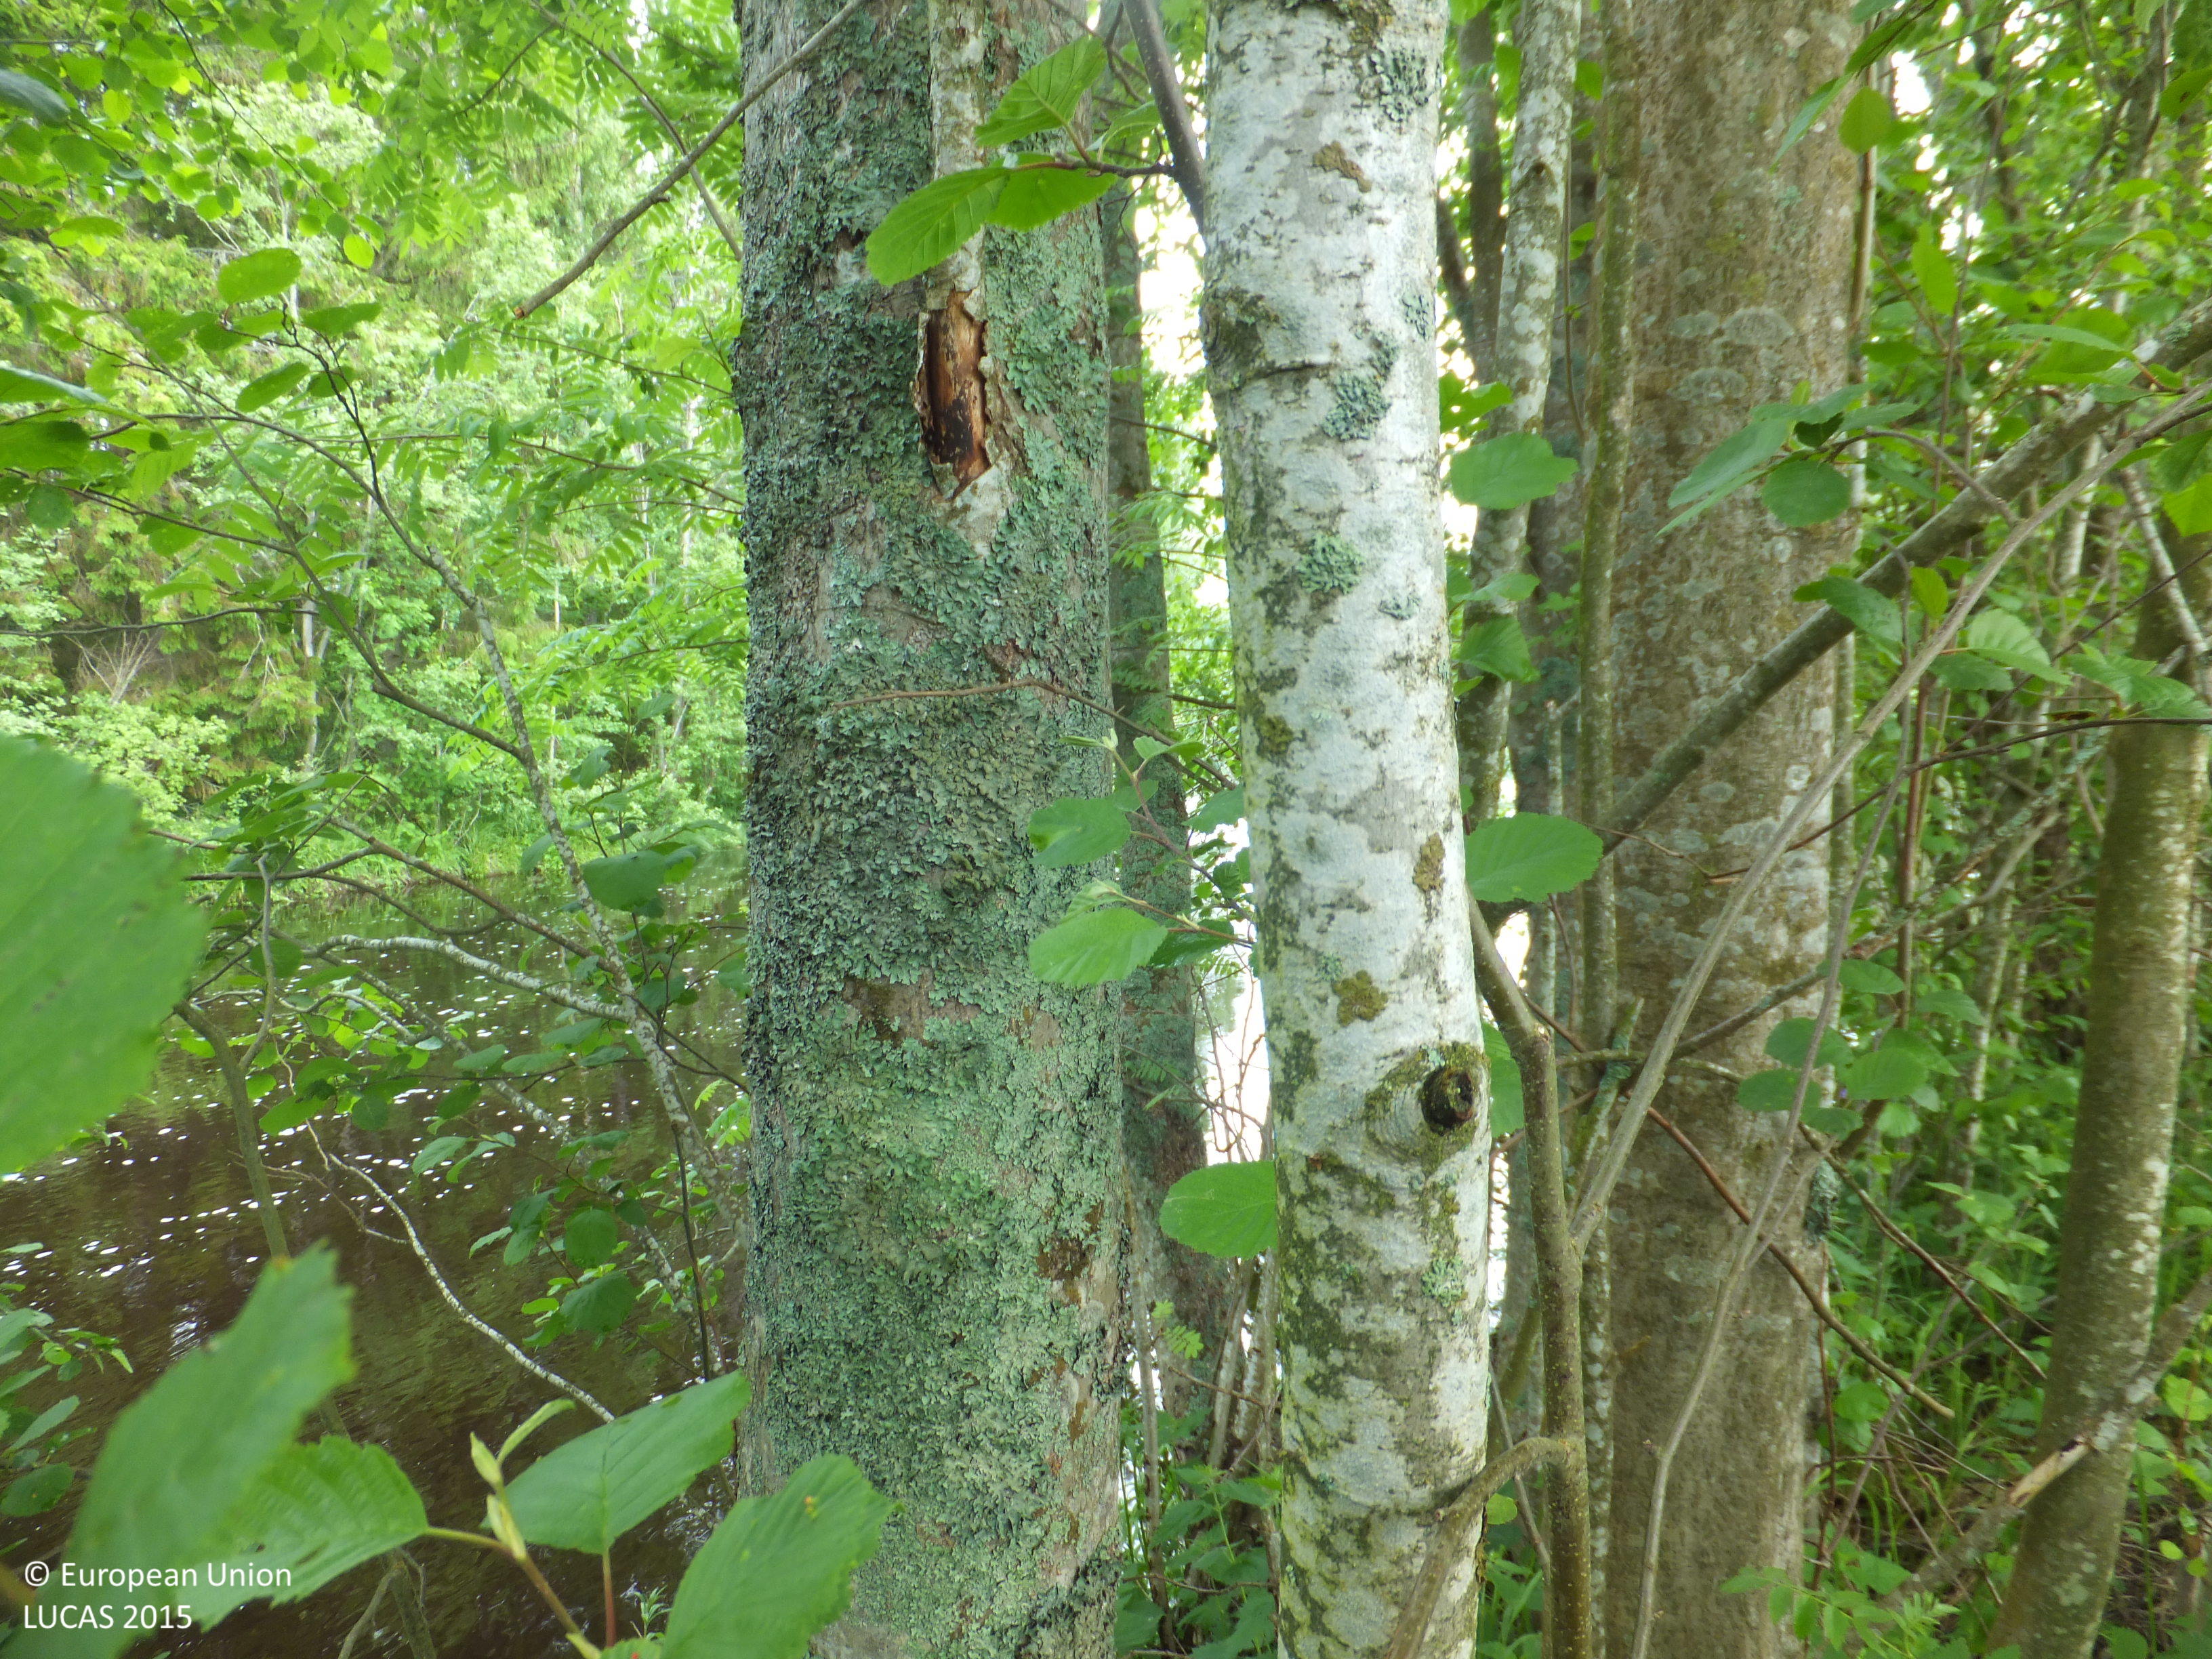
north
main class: Woodland
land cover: Broadleaved woodland
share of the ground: 50 - 75 %
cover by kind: broadleaved forest trees 60 %, herbaceous plants 40 %
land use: Semi-natural and natural areas not in use
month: June
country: FI
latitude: 63.3293
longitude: 24.0309
